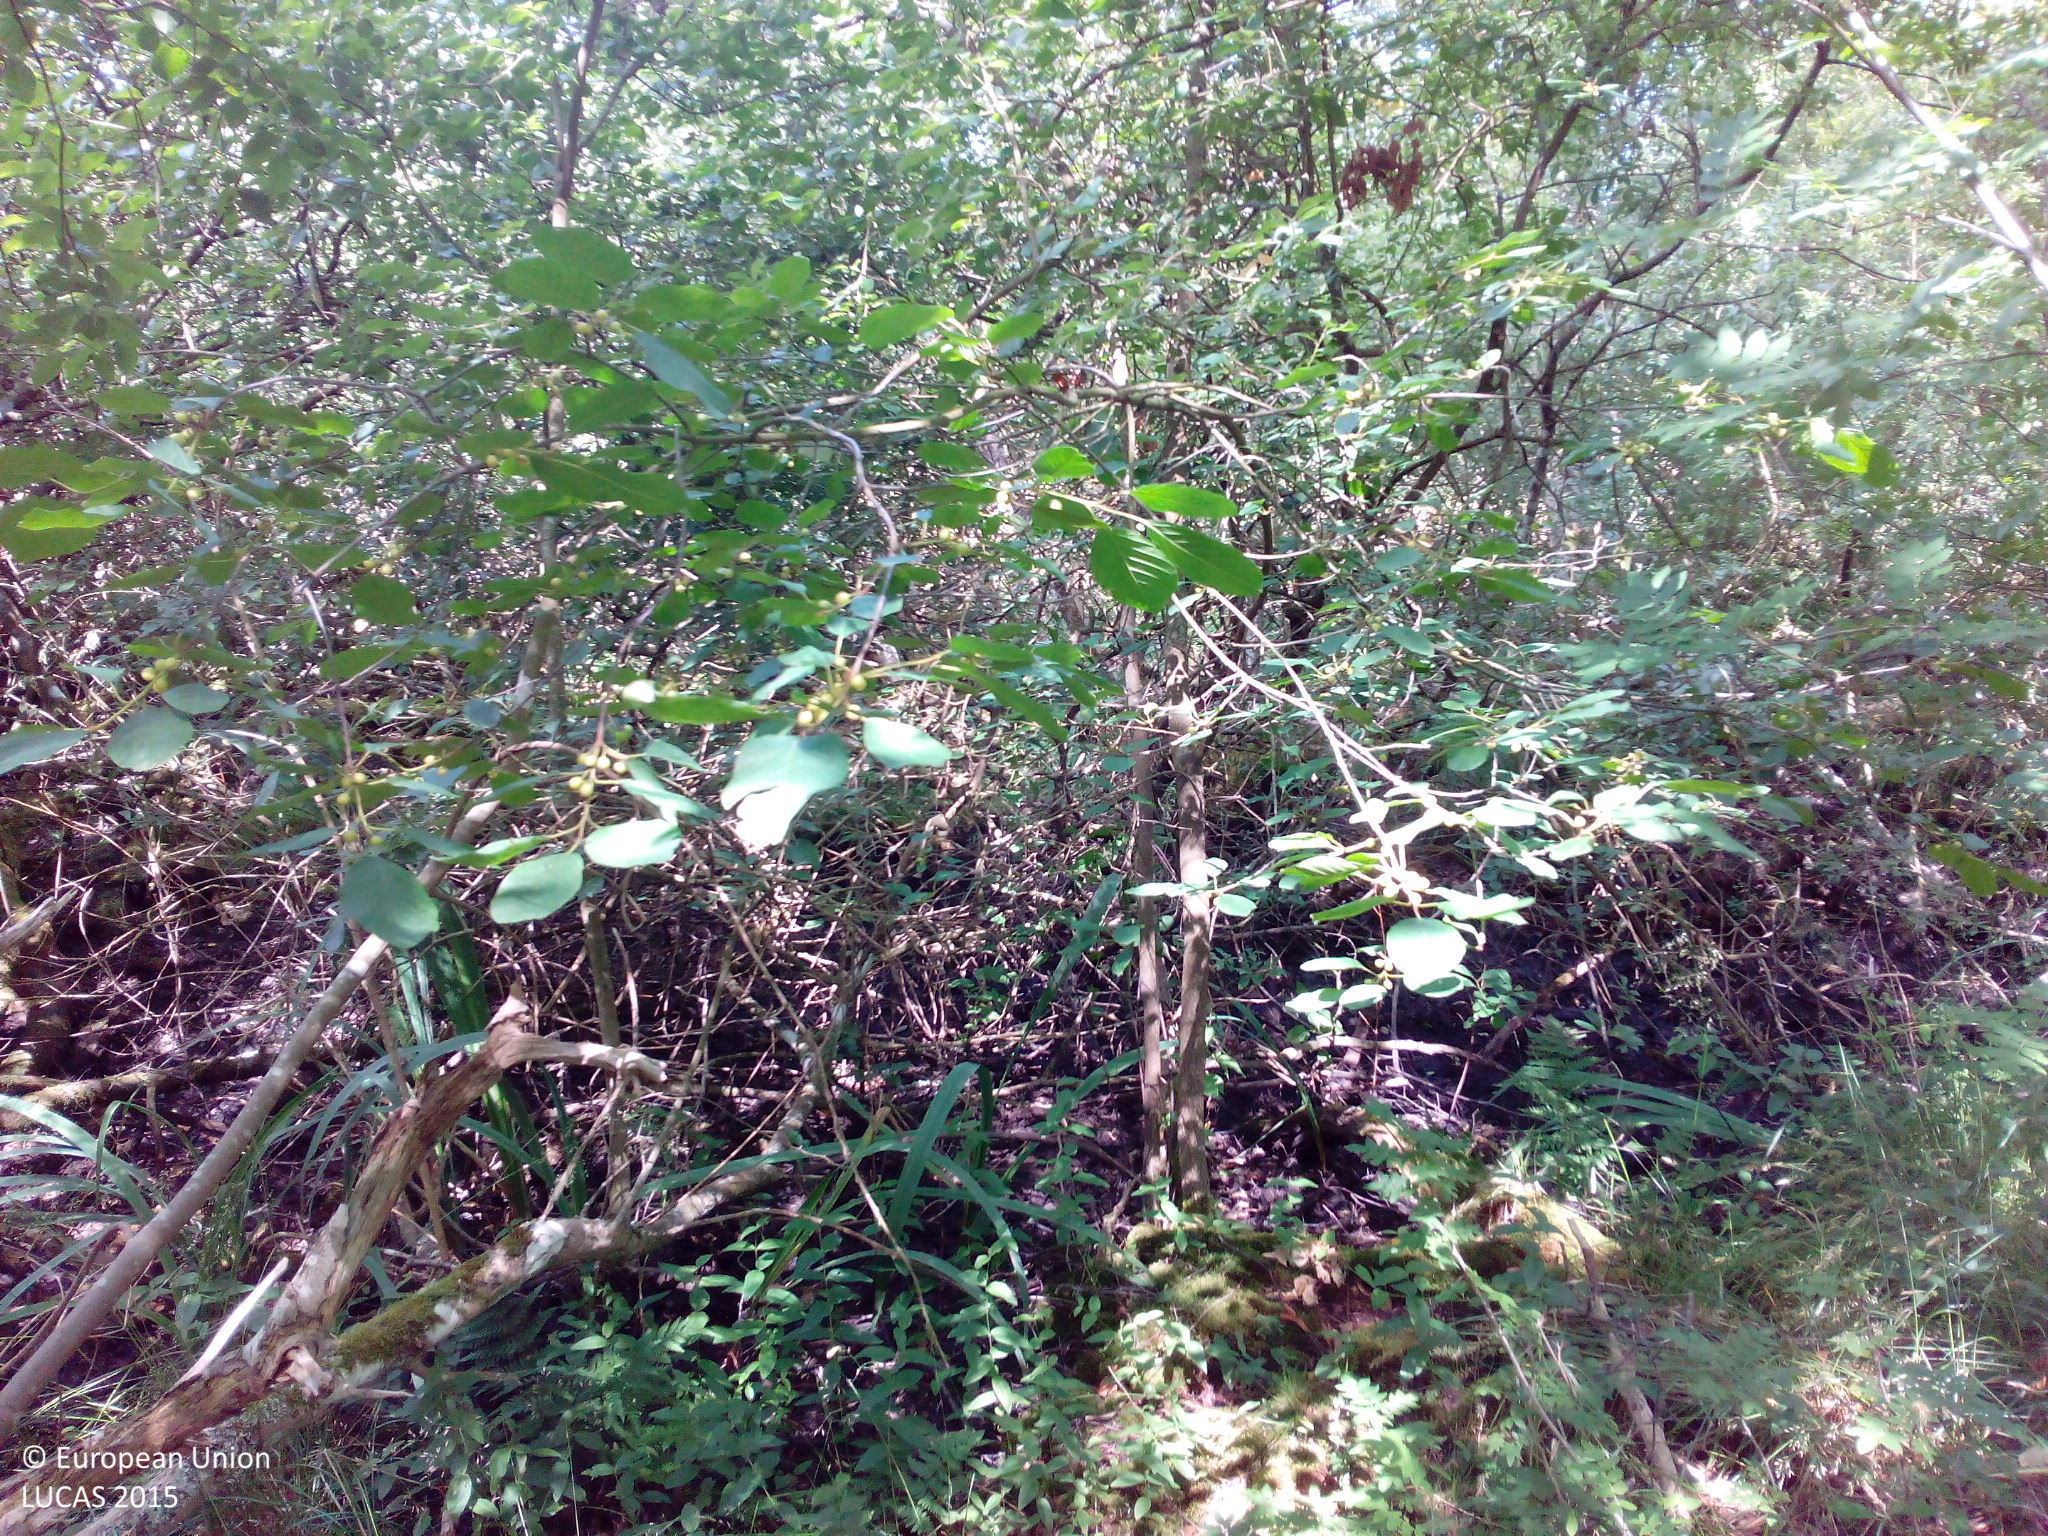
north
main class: Woodland
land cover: Broadleaved woodland
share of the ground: > 75 %
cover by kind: broadleaved forest trees 60 %, herbaceous plants 30 %, shrubs 10 %
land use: Semi-natural and natural areas not in use
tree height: < 5 m
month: July
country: DK
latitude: 56.0093
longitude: 12.0670
